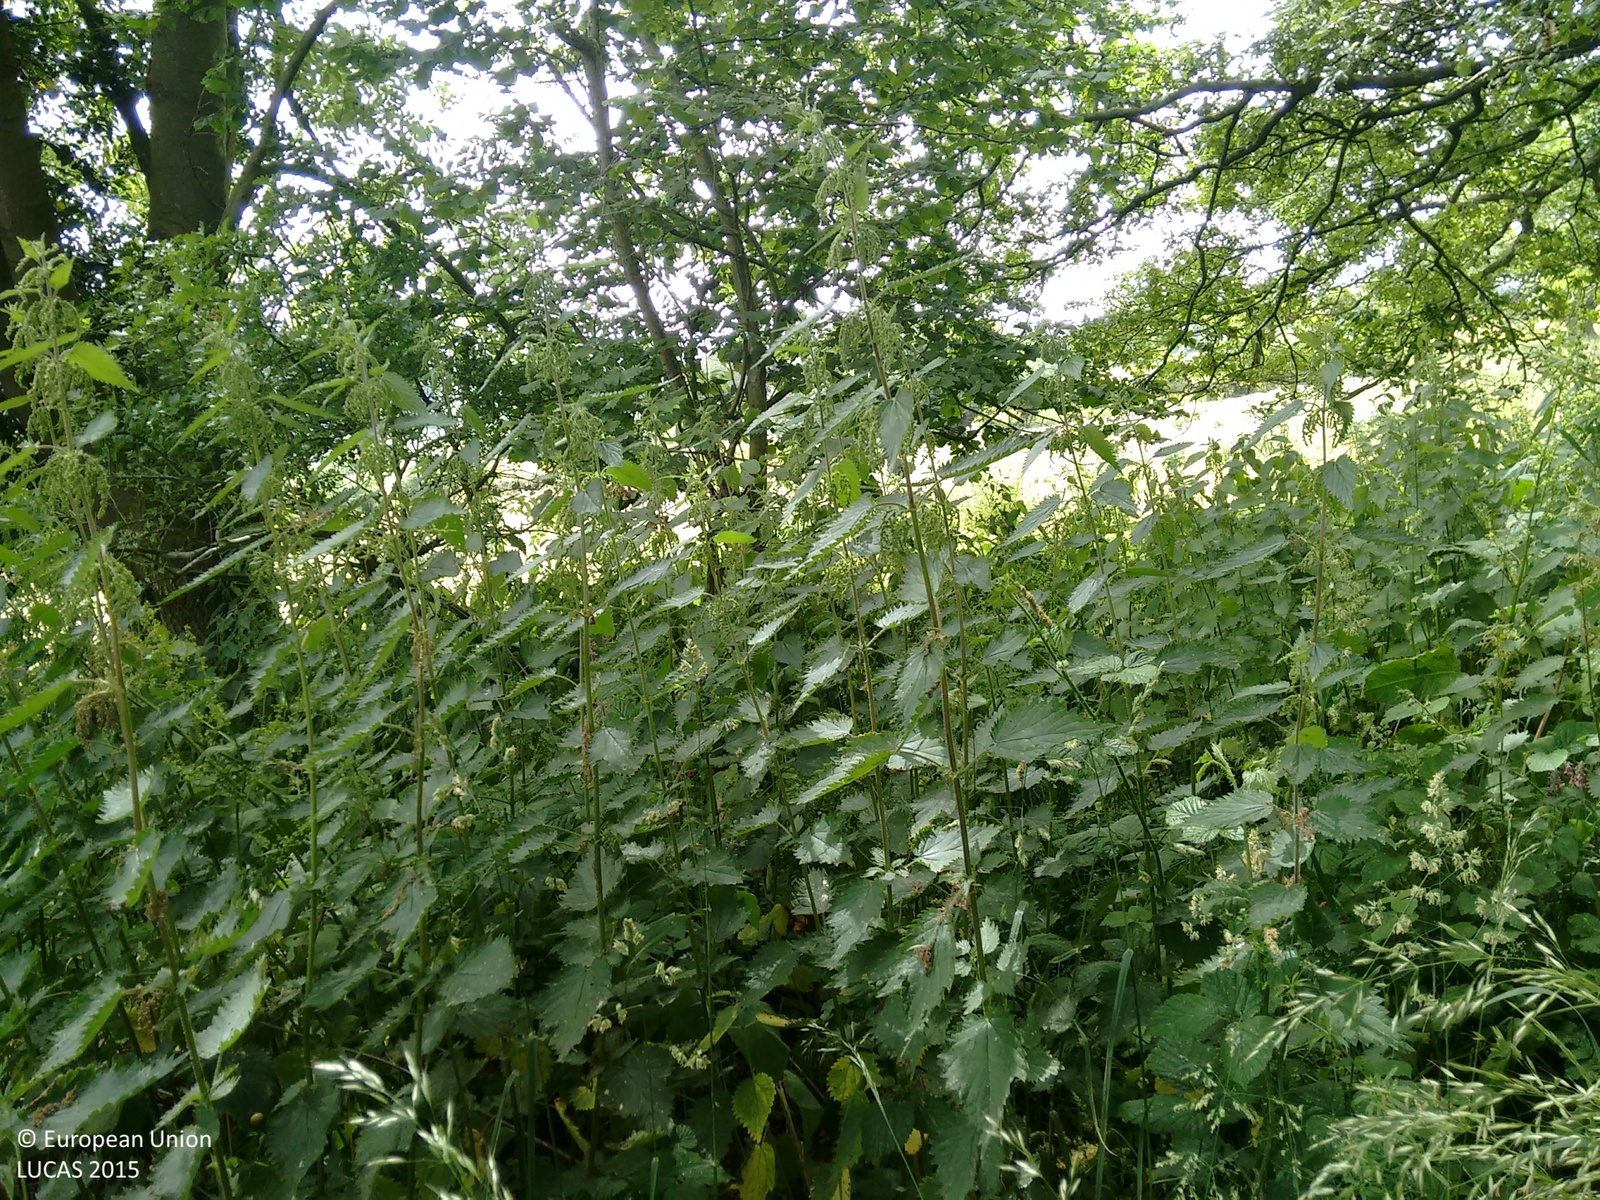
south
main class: Woodland
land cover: Broadleaved woodland
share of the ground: > 75 %
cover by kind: broadleaved forest trees 95 %, shrubs 5 %
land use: Agriculture (excluding fallow land and kitchen gardens)
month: June
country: GB
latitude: 52.3225
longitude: -2.7618
